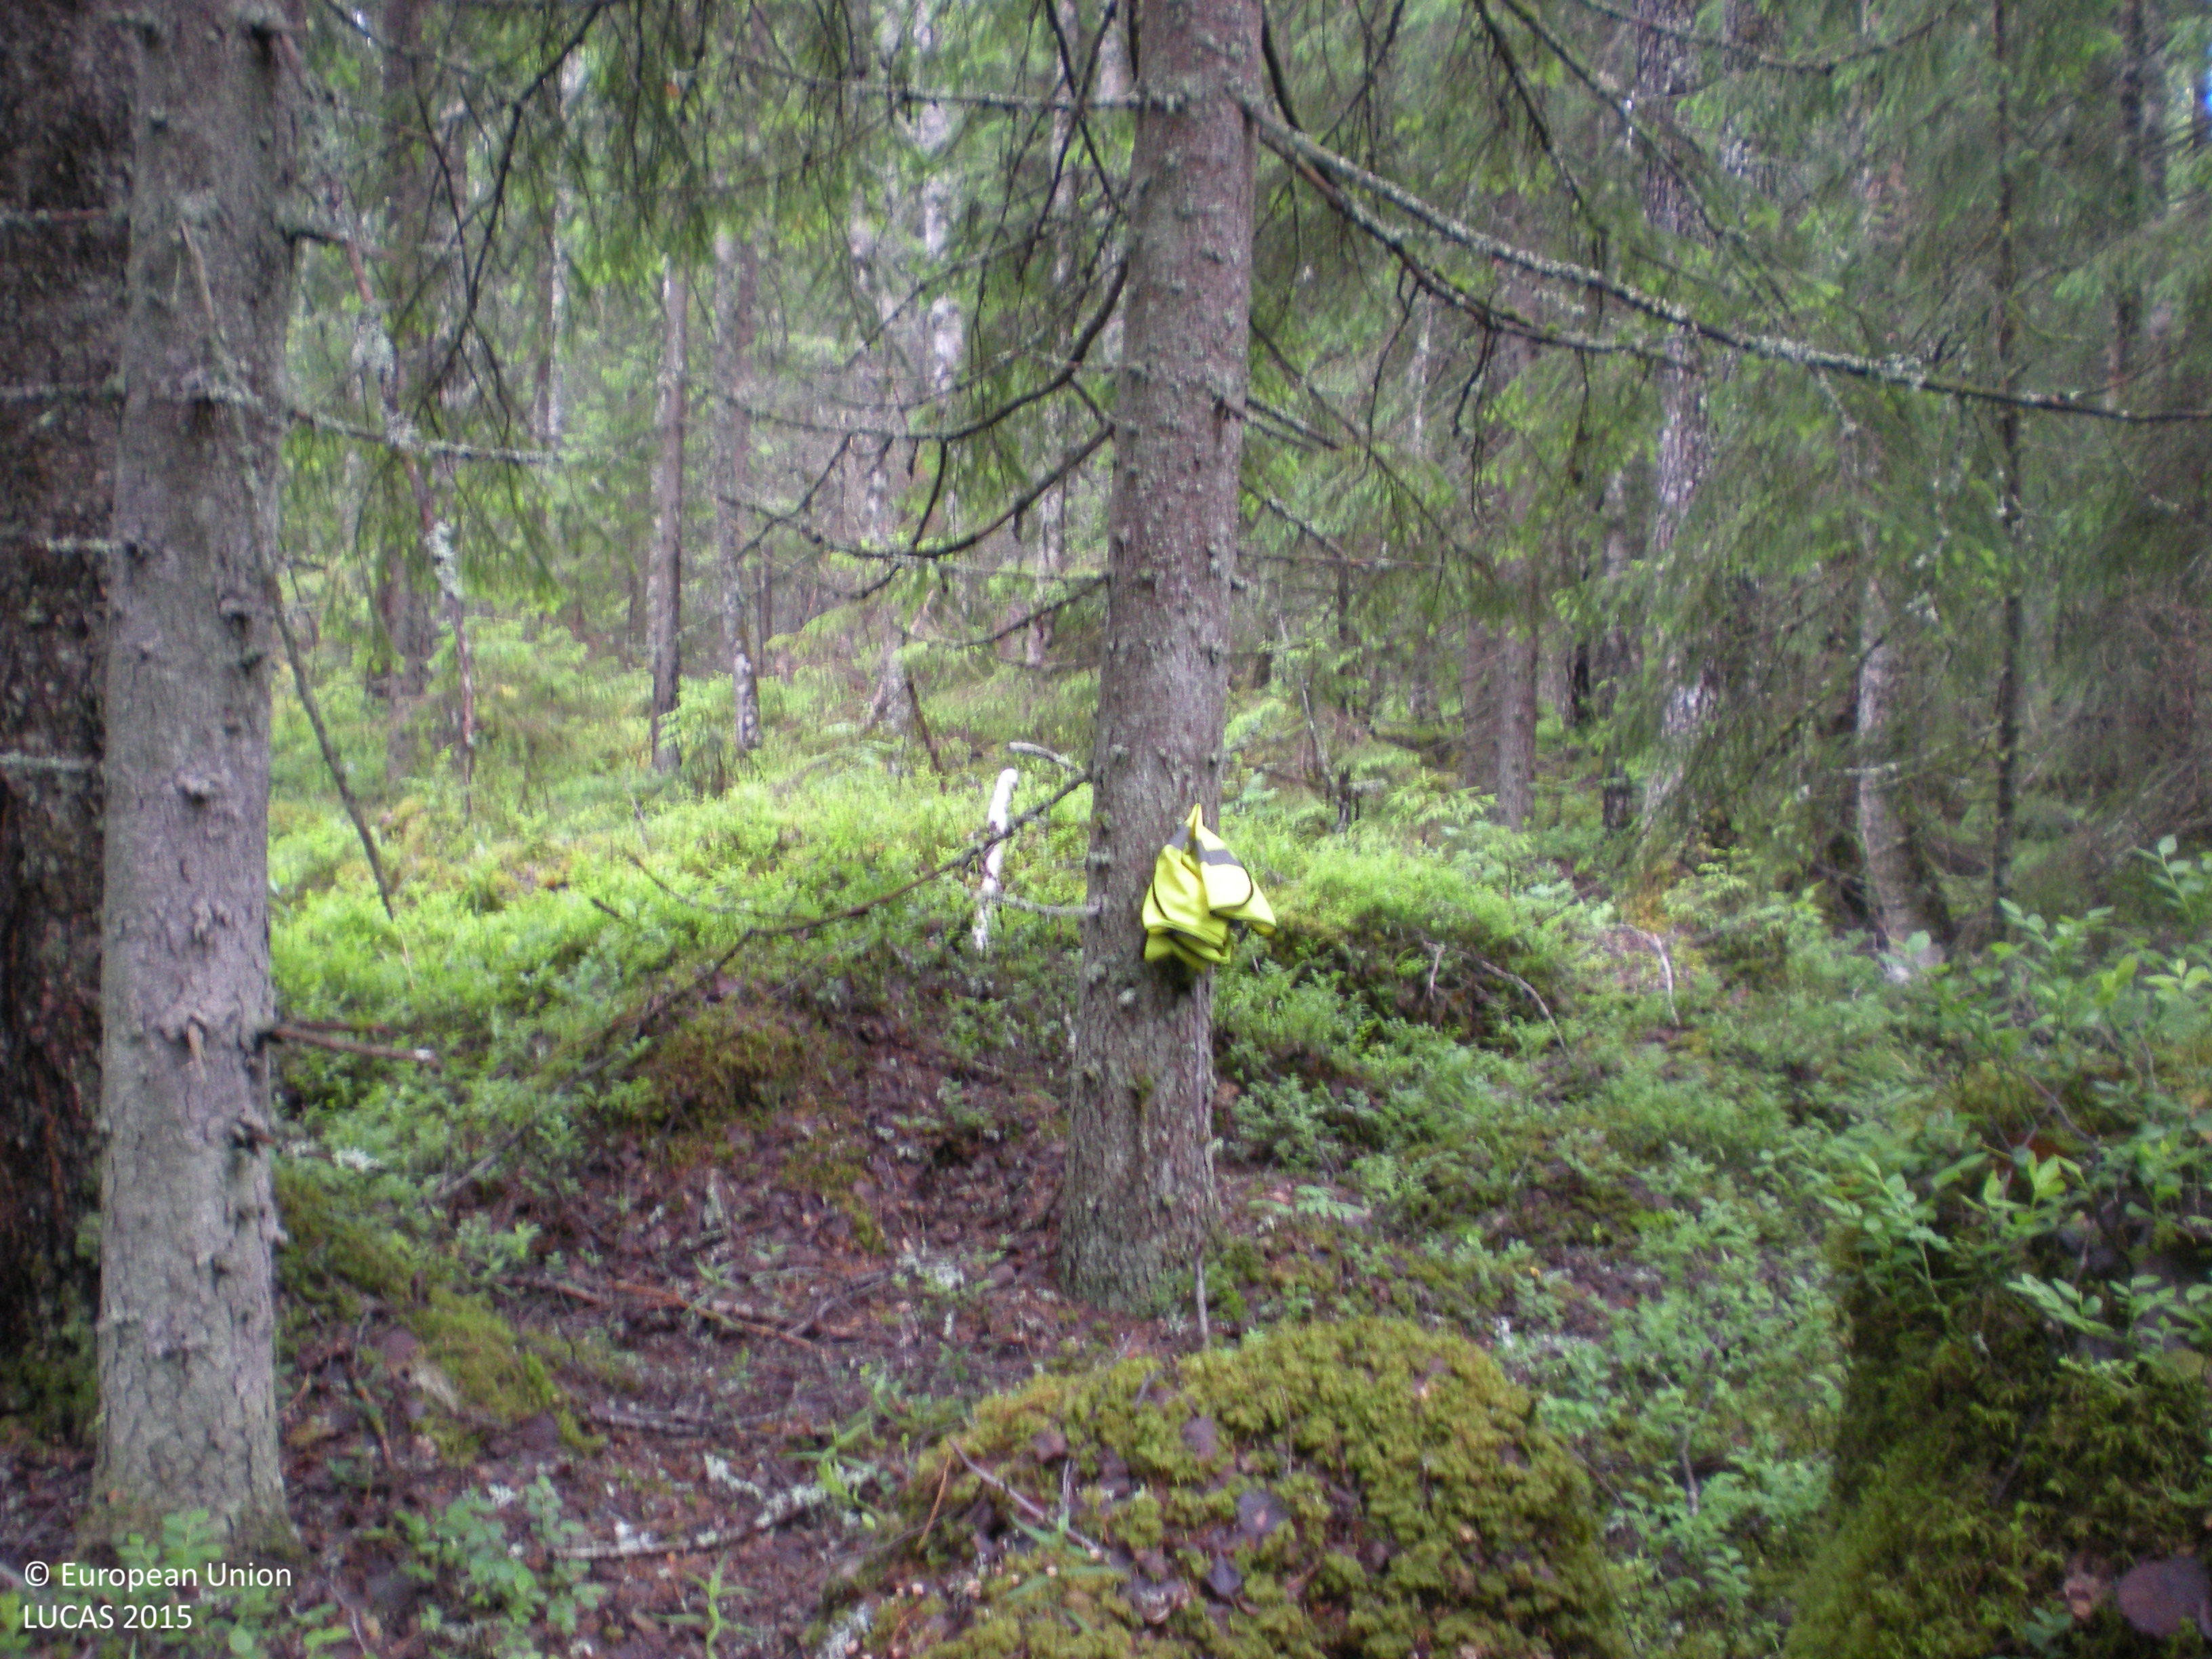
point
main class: Woodland
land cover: Spruce dominated coniferous woodland
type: boreal forest
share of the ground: 50 - 75 %
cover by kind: coniferous forest trees 60 %, lichens and mosses 15 %, broadleaved forest trees 10 %, shrubs 5 %, herbaceous plants 5 %, consolidated bare surface 5 %
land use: Forestry
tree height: > 5 m
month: June
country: SE
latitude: 60.2732
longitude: 17.7852
